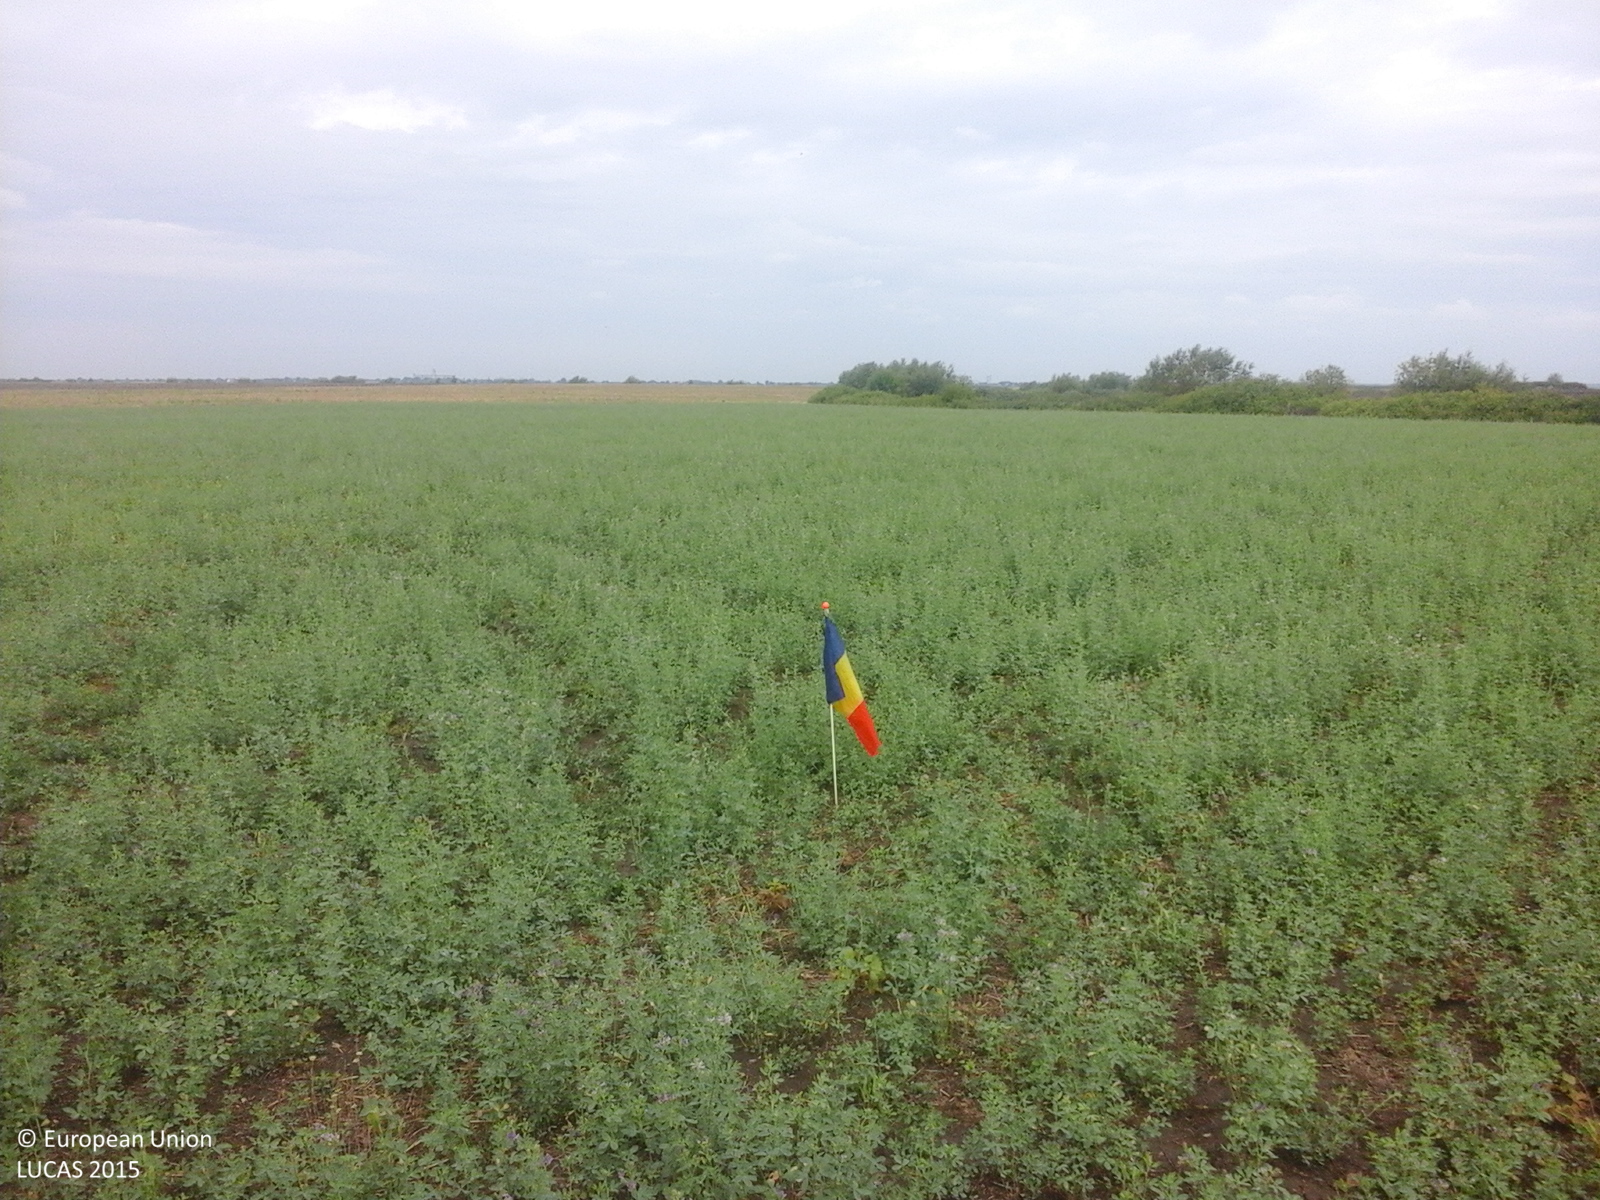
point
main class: Cropland
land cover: Lucerne
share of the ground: > 75 %
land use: Agriculture (excluding fallow land and kitchen gardens)
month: August
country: RO
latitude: 45.5364
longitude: 21.2605
